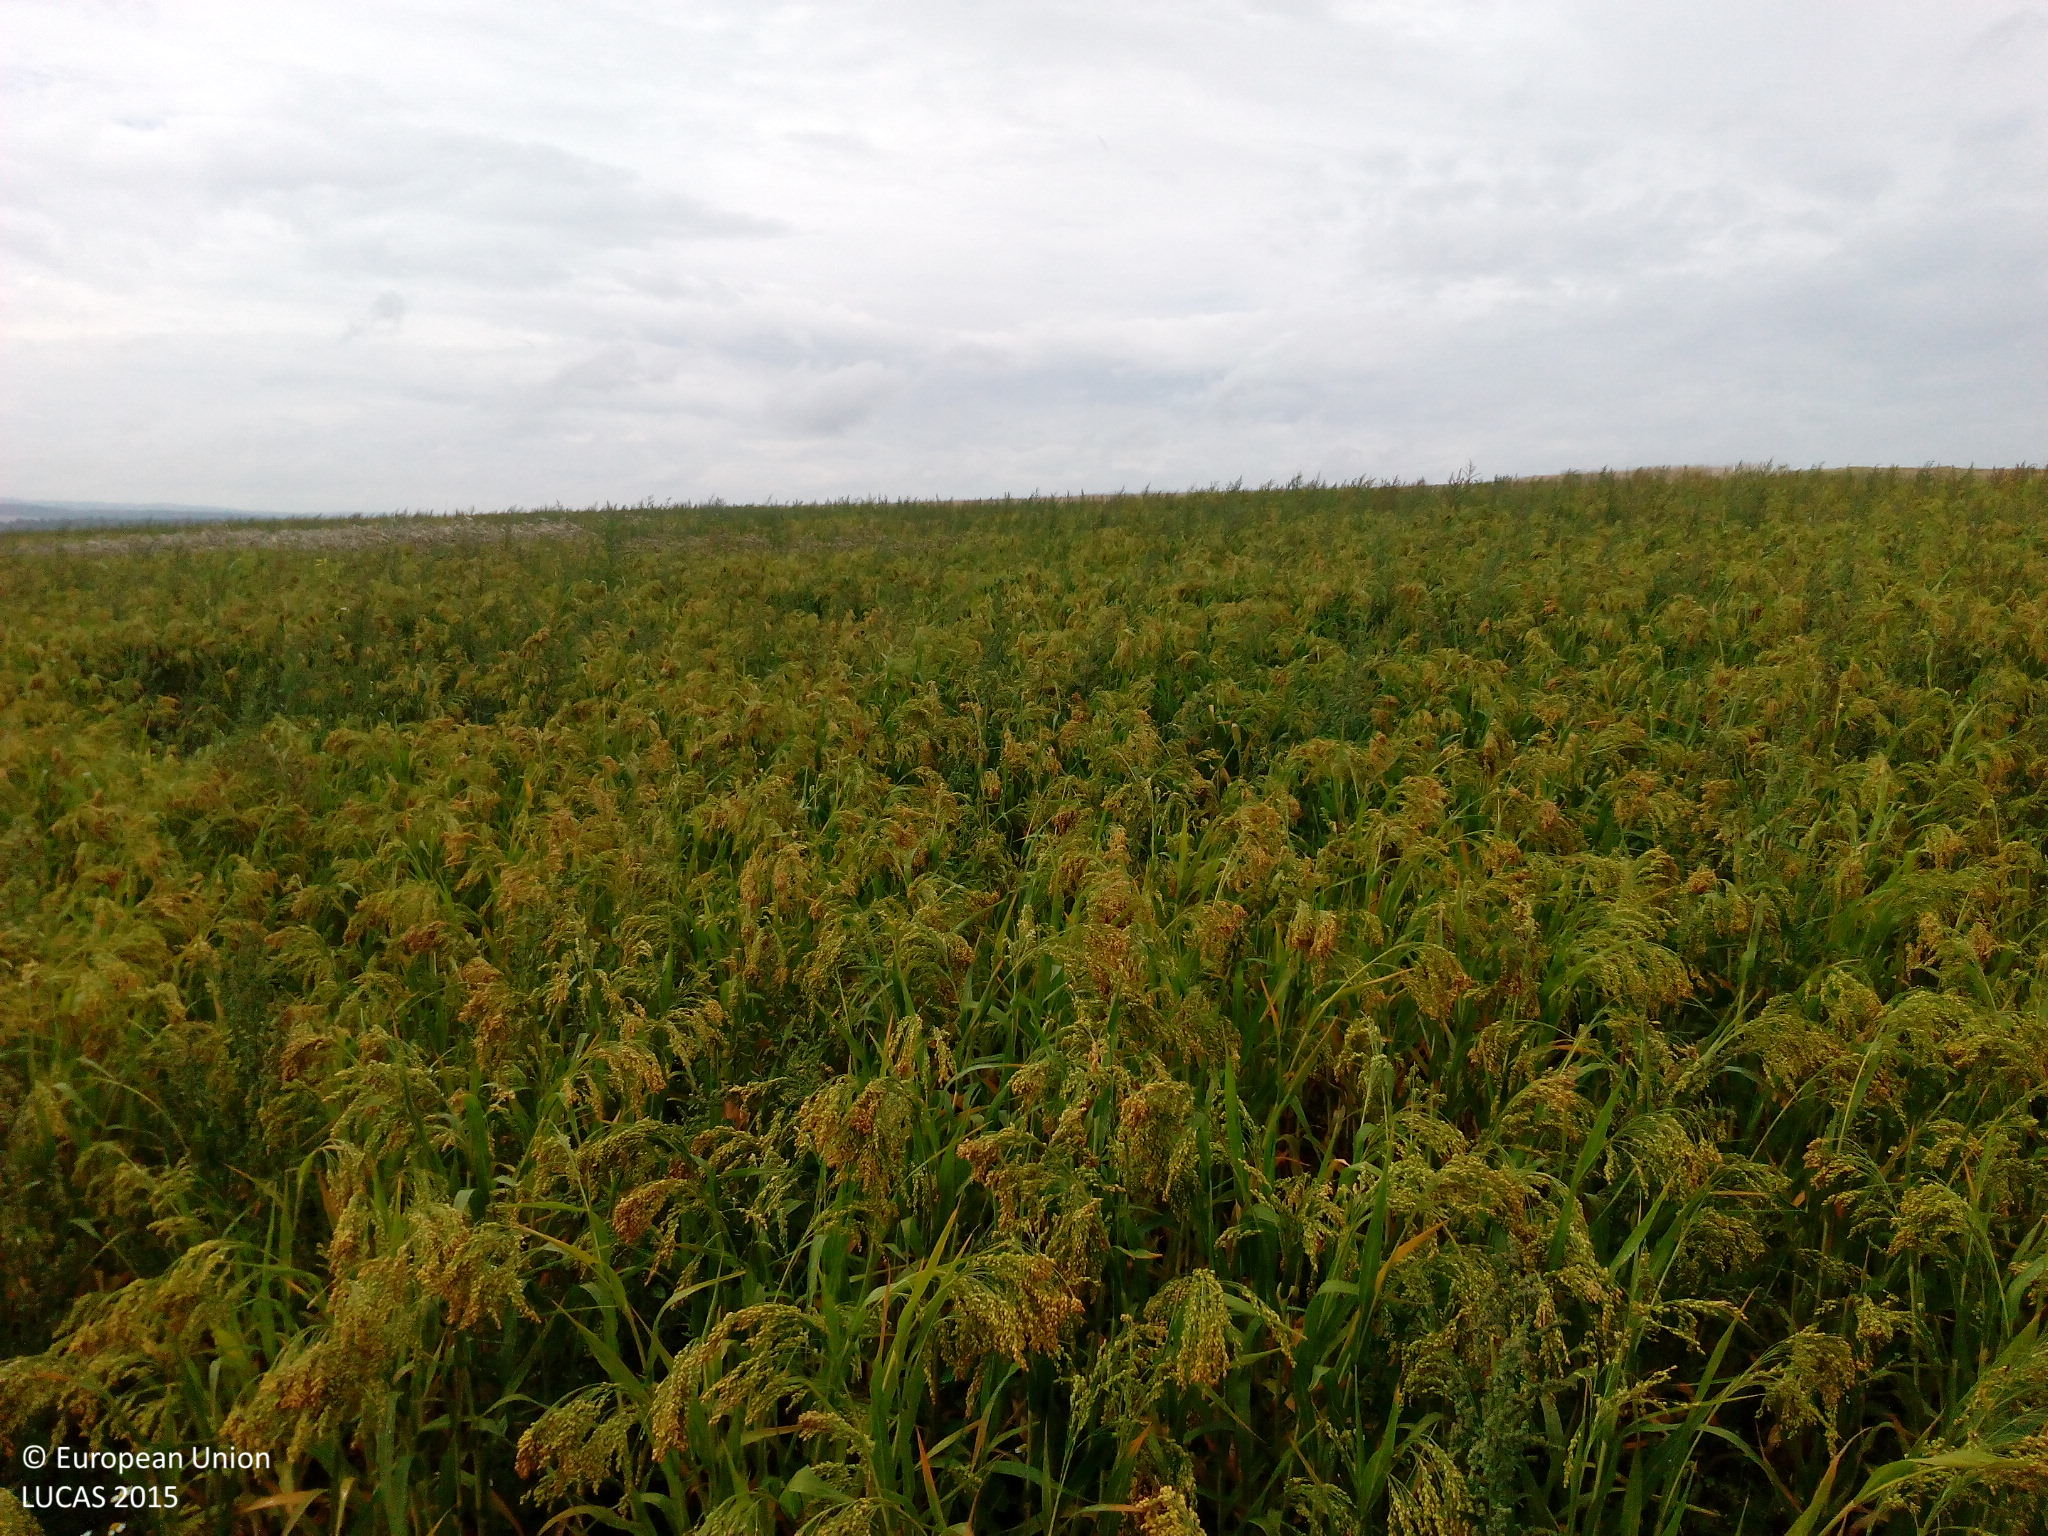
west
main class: Cropland
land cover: Other cereals
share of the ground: > 75 %
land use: Agriculture (excluding fallow land and kitchen gardens)
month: August
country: DE
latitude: 50.2409
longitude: 8.1355
